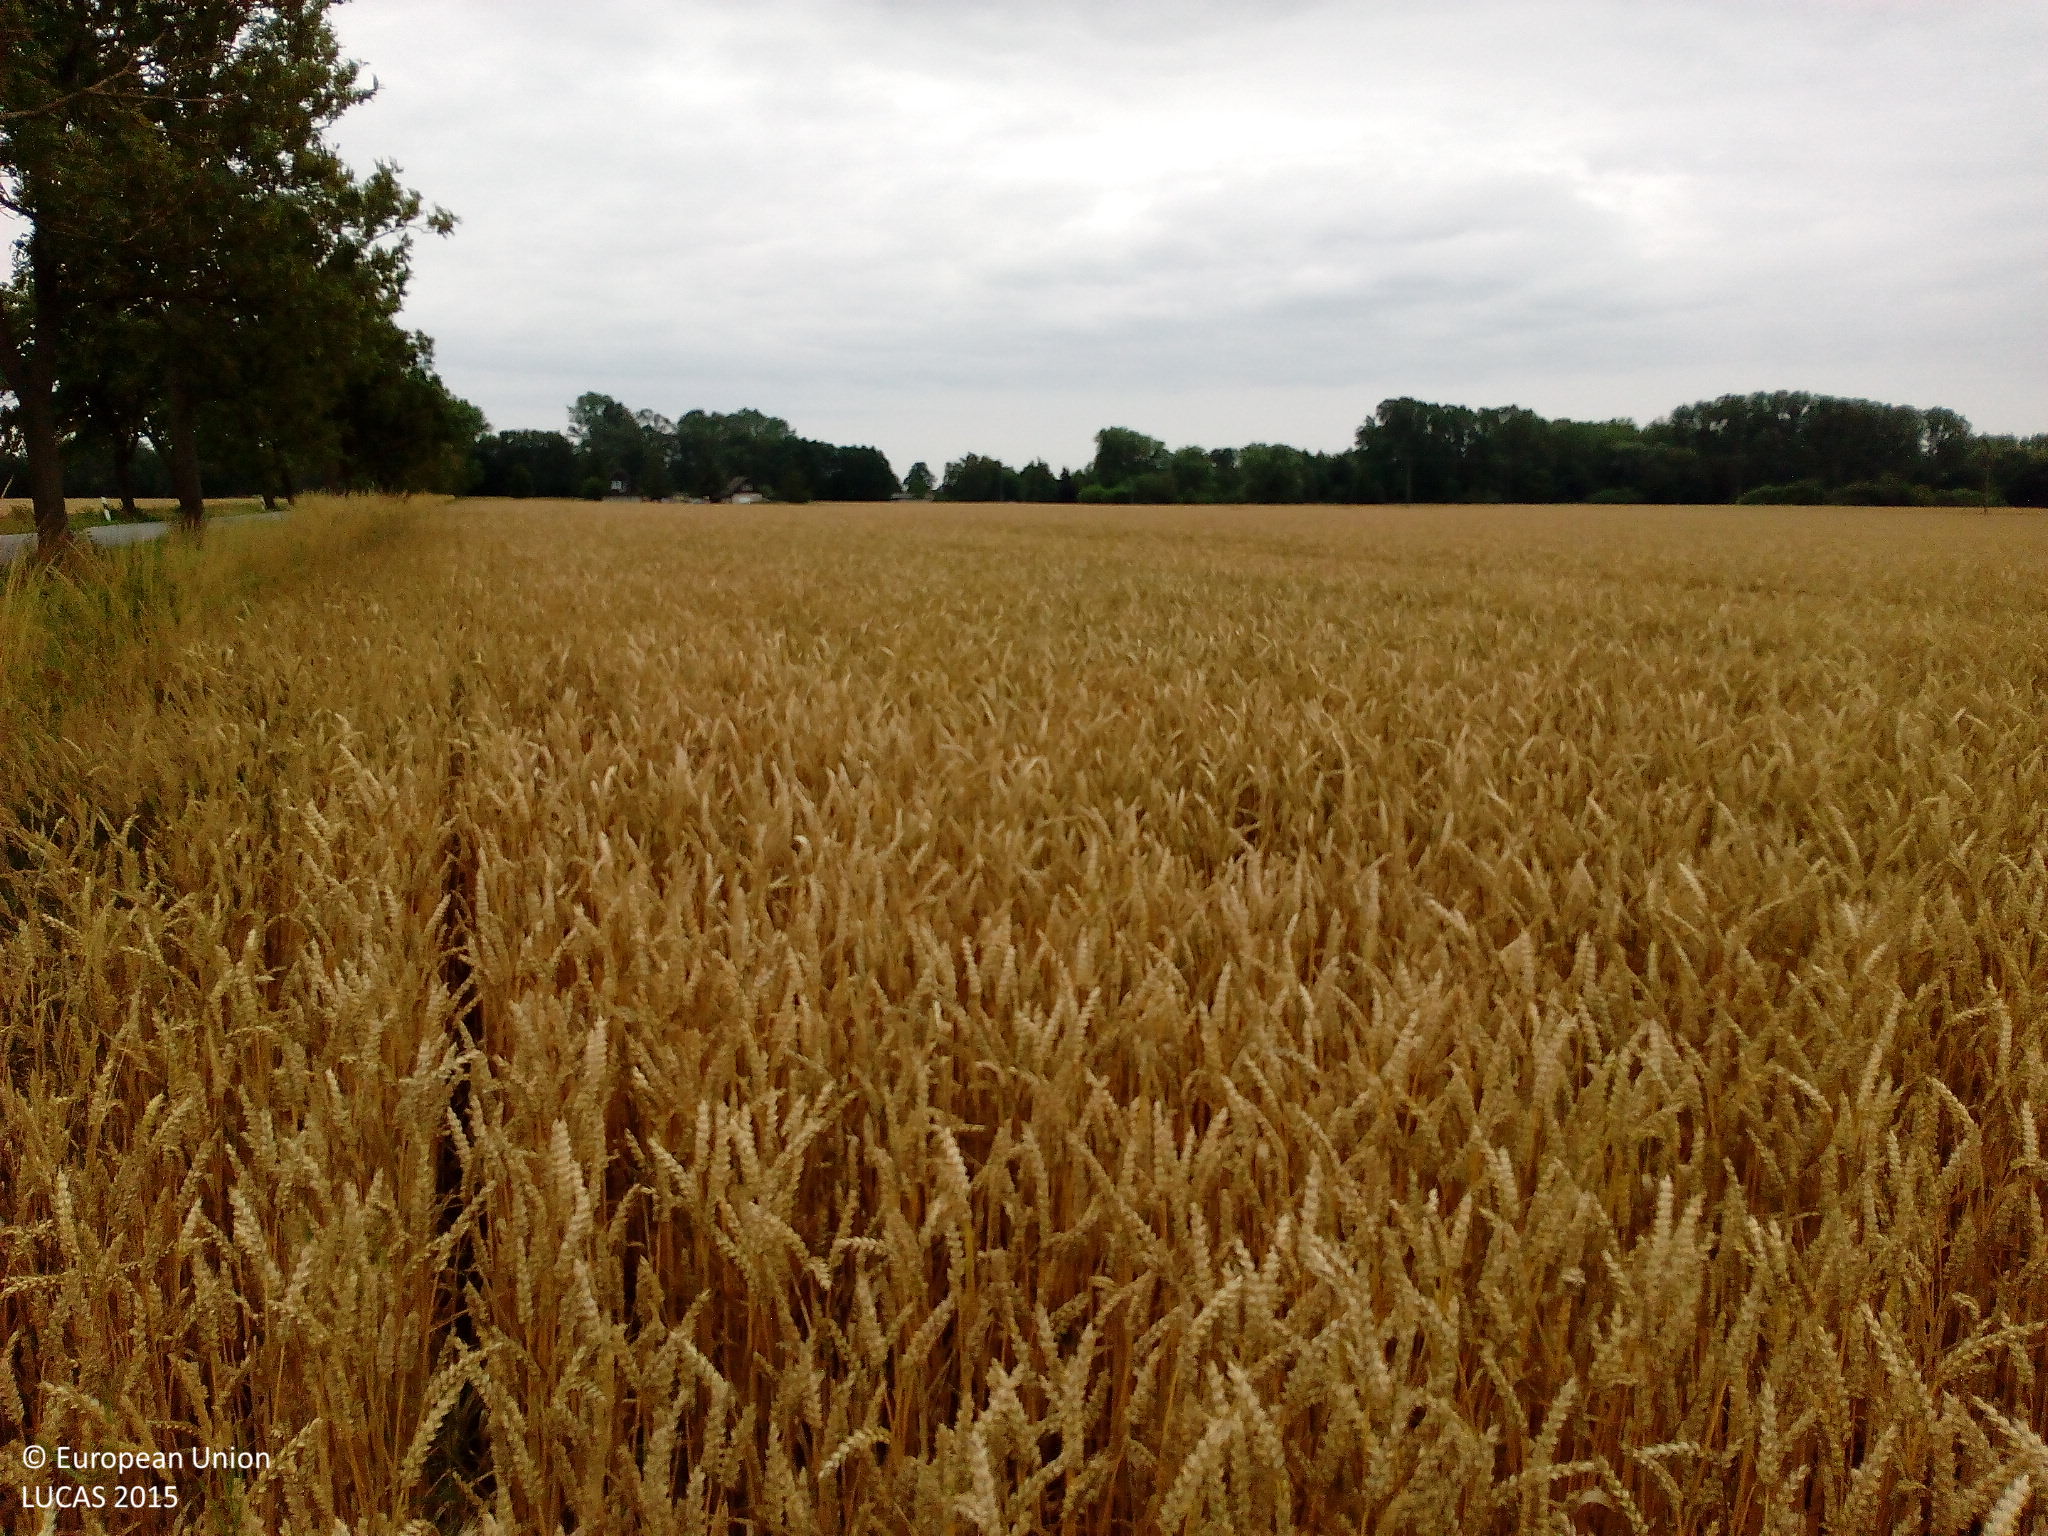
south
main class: Cropland
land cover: Common wheat
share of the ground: > 75 %
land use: Agriculture (excluding fallow land and kitchen gardens)
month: July
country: DE
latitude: 54.2758
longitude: 12.4715
